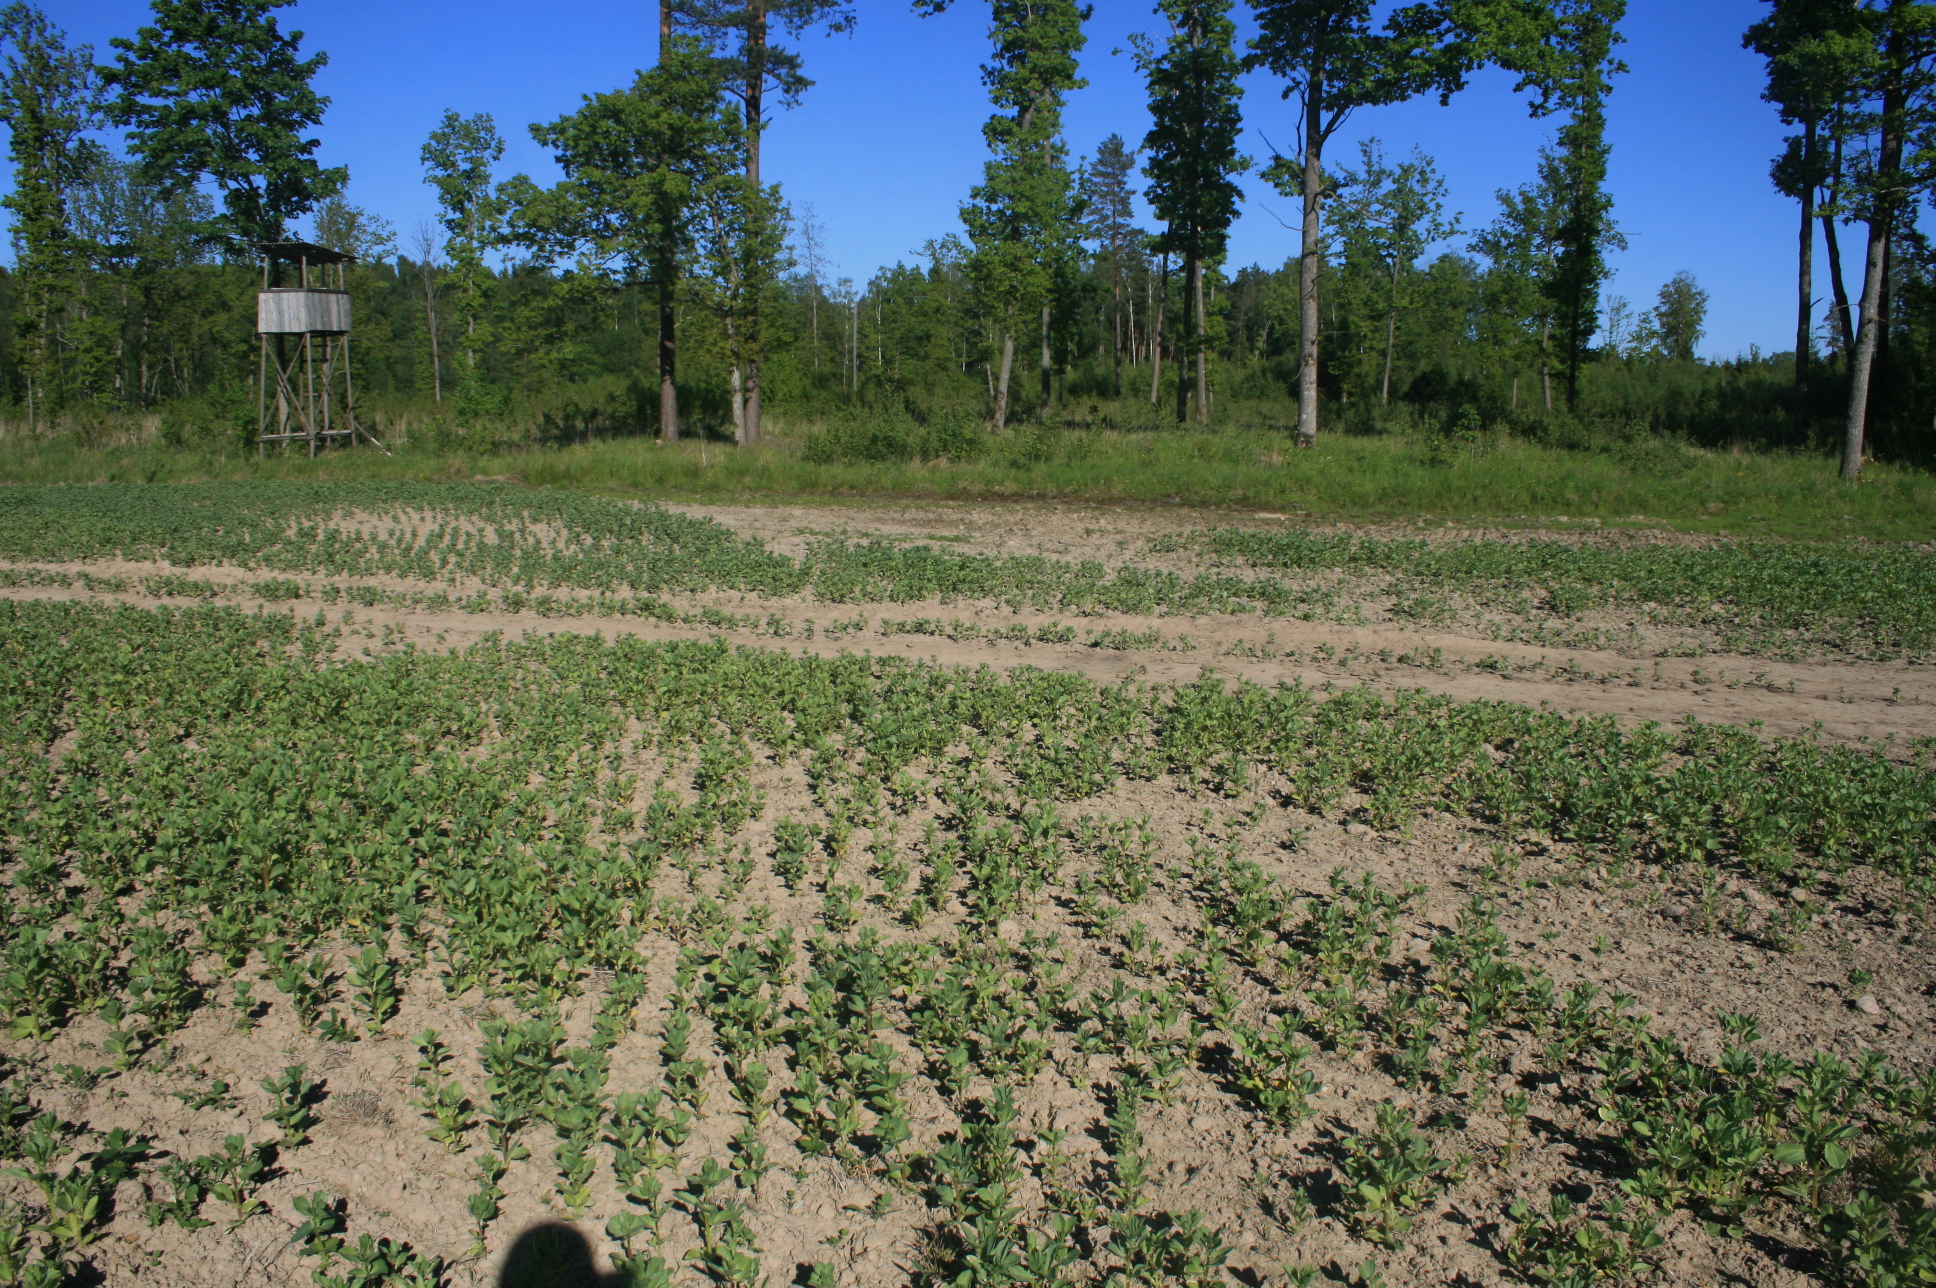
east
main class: Cropland
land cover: Dry pulses
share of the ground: 50 - 75 %
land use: Agriculture (excluding fallow land and kitchen gardens)
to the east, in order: Dry pulses; Broadleaved woodland; Grassland with sparse tree/shrub cover; Broadleaved woodland
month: June
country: LT
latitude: 55.9508
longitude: 21.3971
